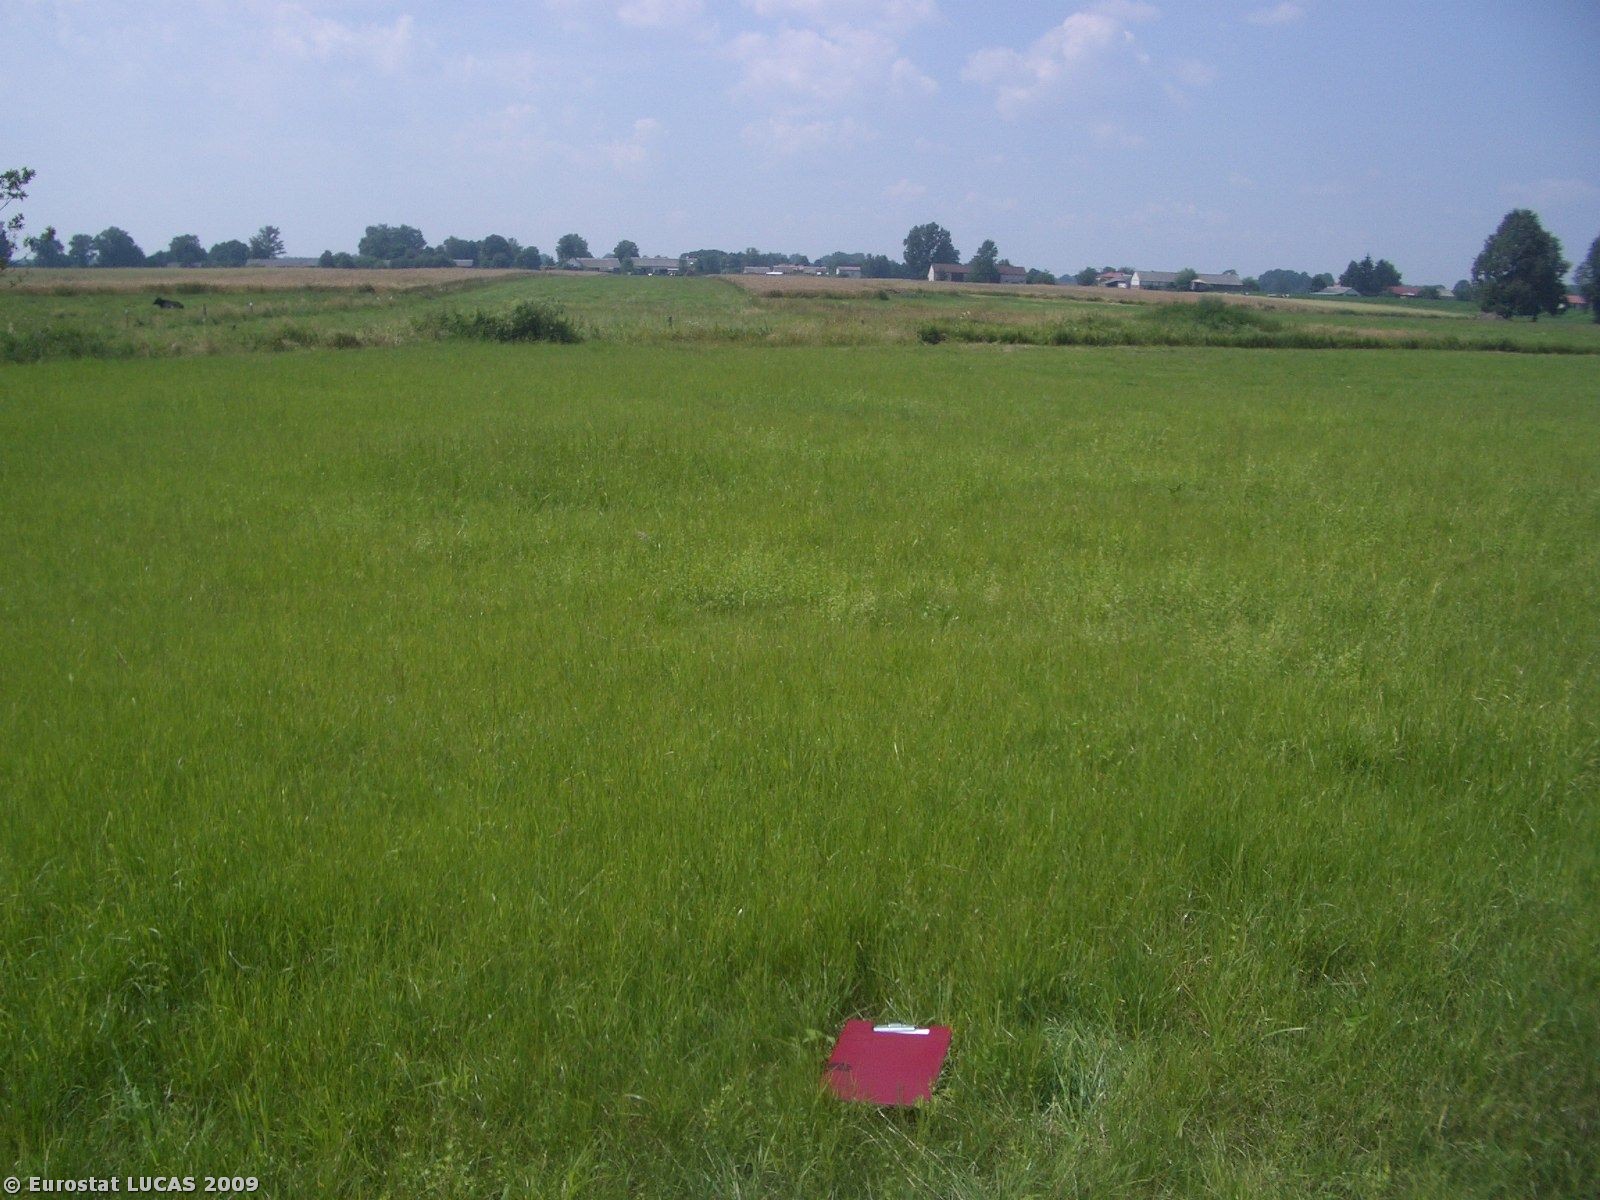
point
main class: Grassland
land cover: Grassland without tree/shrub cover
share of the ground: > 75 %
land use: Agriculture (excluding fallow land and kitchen gardens)
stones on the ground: < 10 %
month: July
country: PL
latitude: 51.4662
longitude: 22.4305
